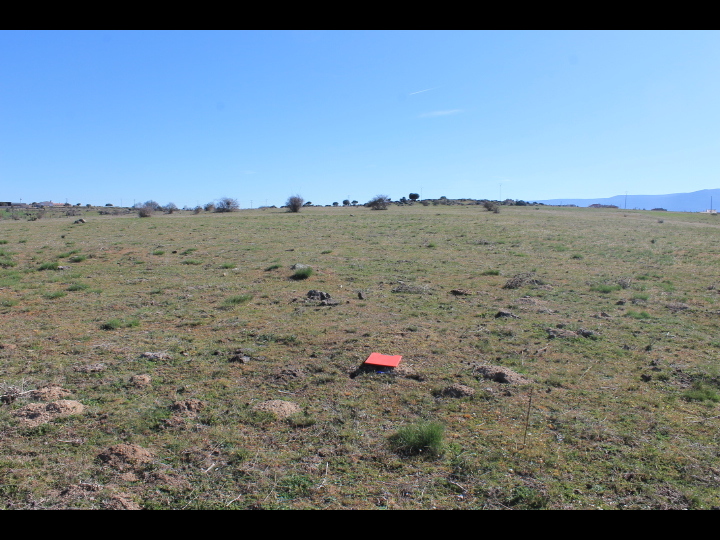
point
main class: Grassland
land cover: Grassland without tree/shrub cover
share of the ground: > 75 %
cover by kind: herbaceous plants 95 %, unconsolidated bare surface 5 %
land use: Agriculture (excluding fallow land and kitchen gardens)
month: April
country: ES
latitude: 40.9896
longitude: -4.0643
